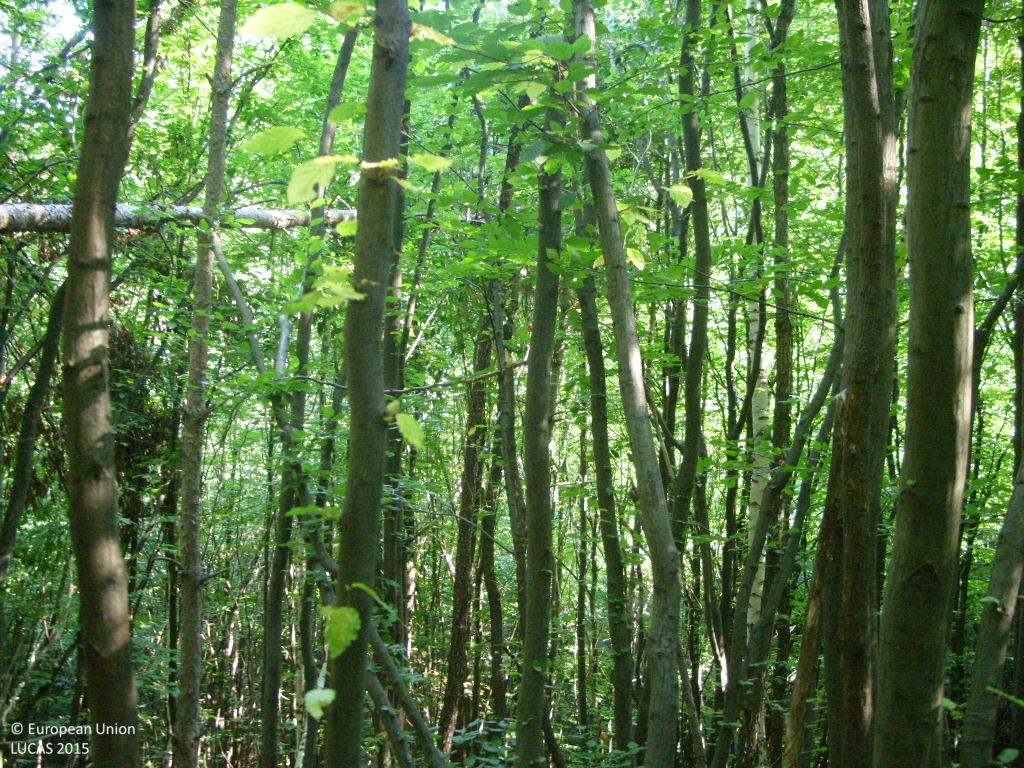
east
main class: Woodland
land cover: Broadleaved woodland
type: mesophytic deciduous forest
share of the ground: > 75 %
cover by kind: broadleaved forest trees 100 %
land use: Forestry
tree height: > 5 m
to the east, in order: Broadleaved woodland; Rivers and streams; Broadleaved woodland
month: July
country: BG
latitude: 42.2939
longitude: 23.9020
